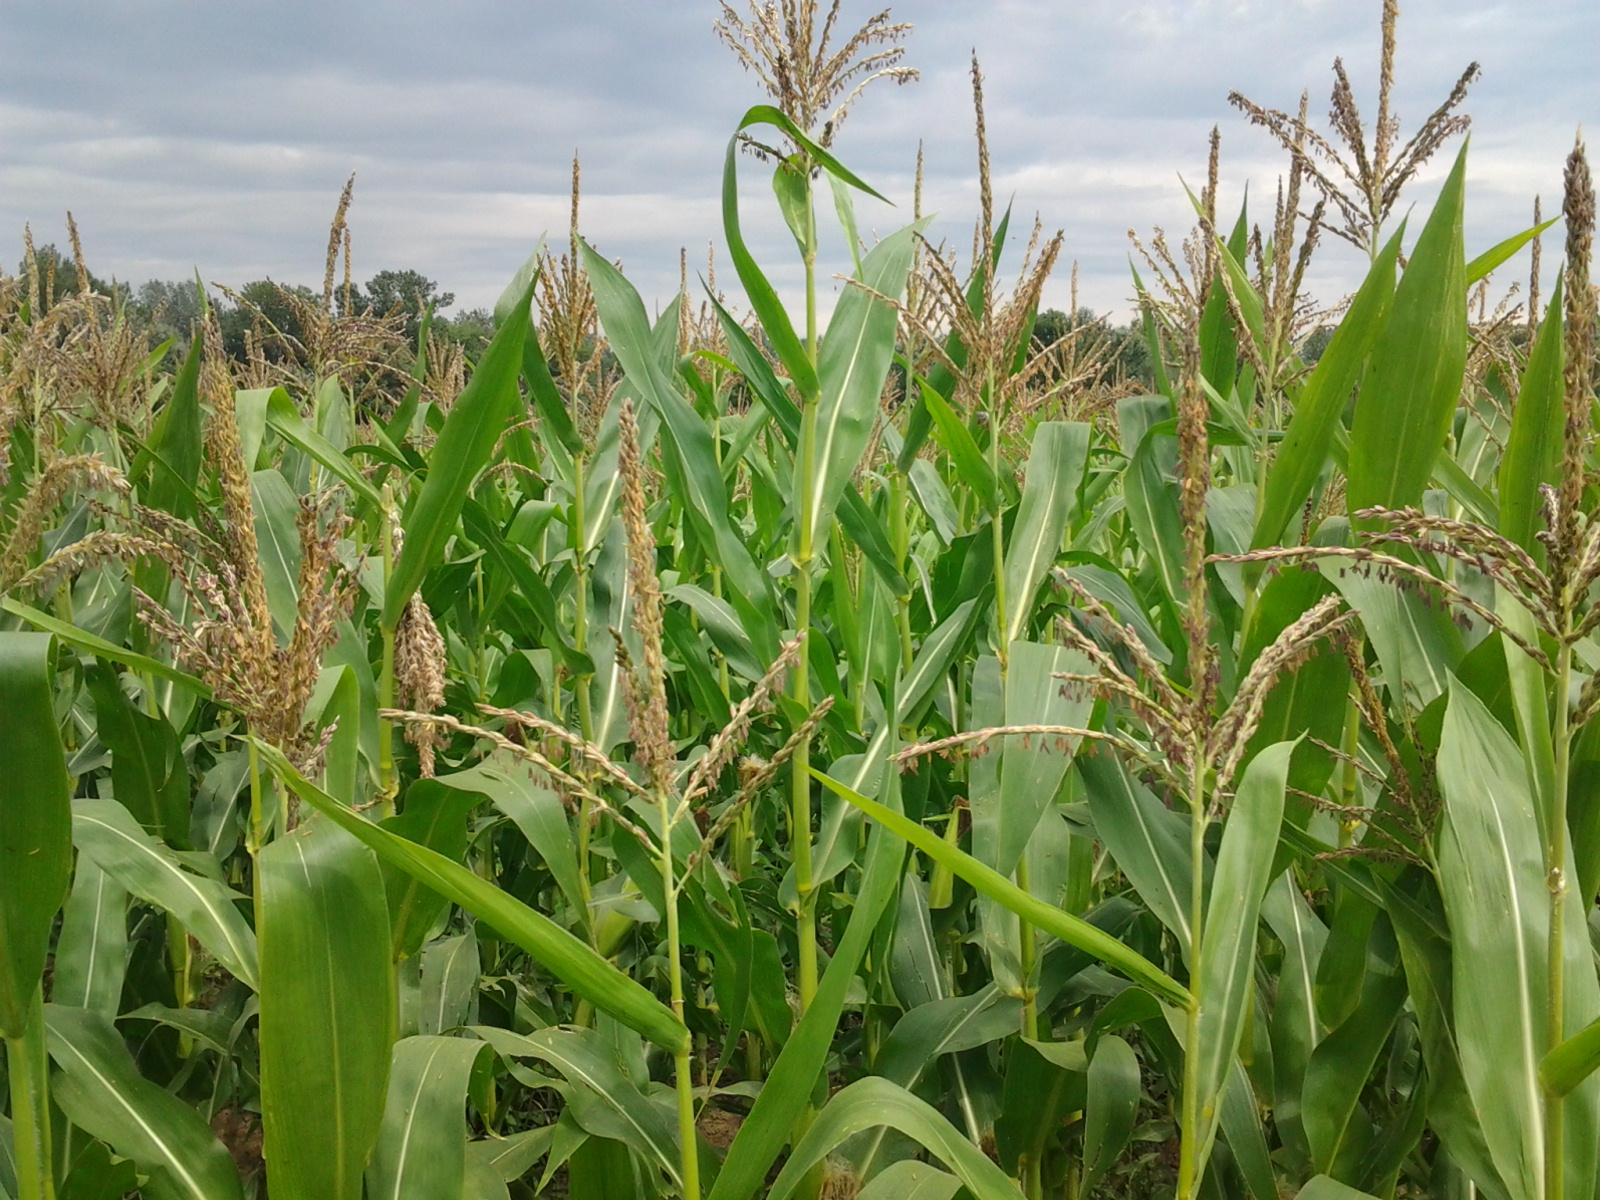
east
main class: Cropland
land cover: Maize
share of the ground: > 75 %
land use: Agriculture (excluding fallow land and kitchen gardens)
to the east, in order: Maize; Sunflower; Maize; Shruby margins; Shrubland with sparse tree cover
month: June
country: HU
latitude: 47.1180
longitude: 20.1615
